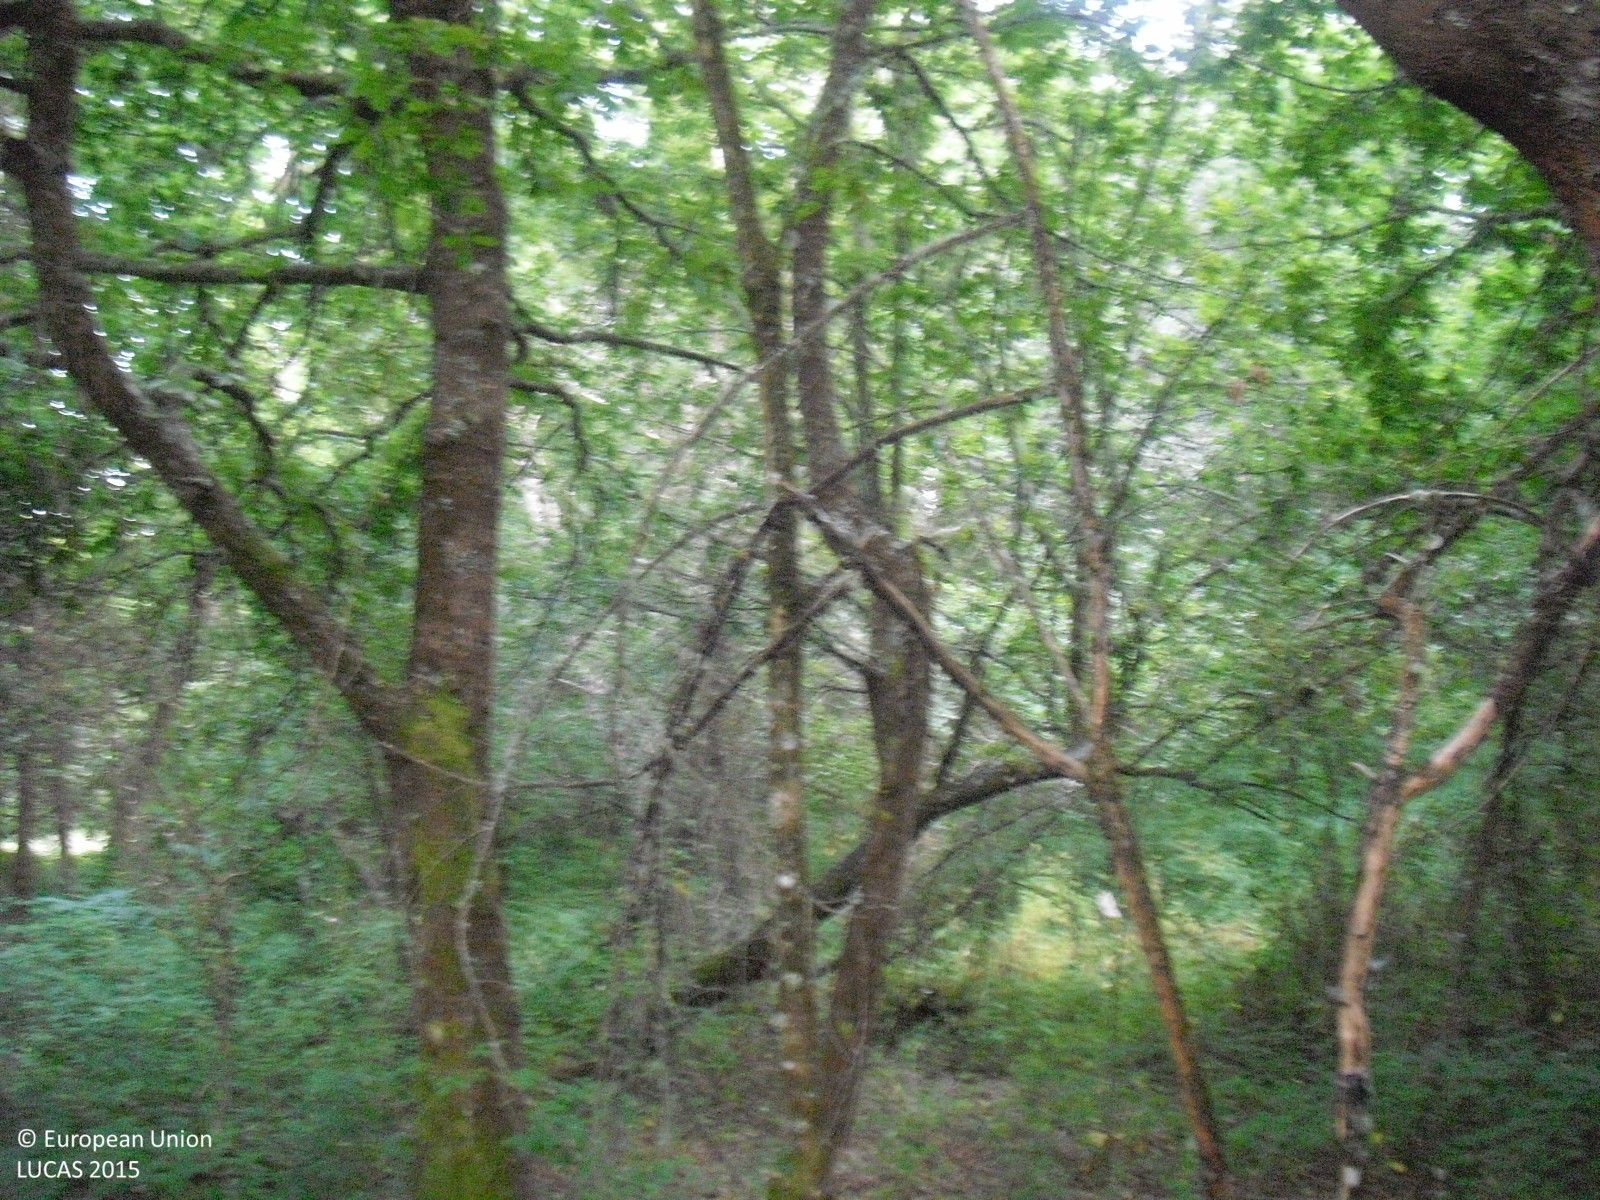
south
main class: Woodland
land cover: Broadleaved woodland
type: acidophilous oak and oak-birch forest
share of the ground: > 75 %
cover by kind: broadleaved forest trees 70 %, shrubs 30 %
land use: Forestry
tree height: > 5 m
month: July
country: ES
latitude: 42.3292
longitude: -7.7304
